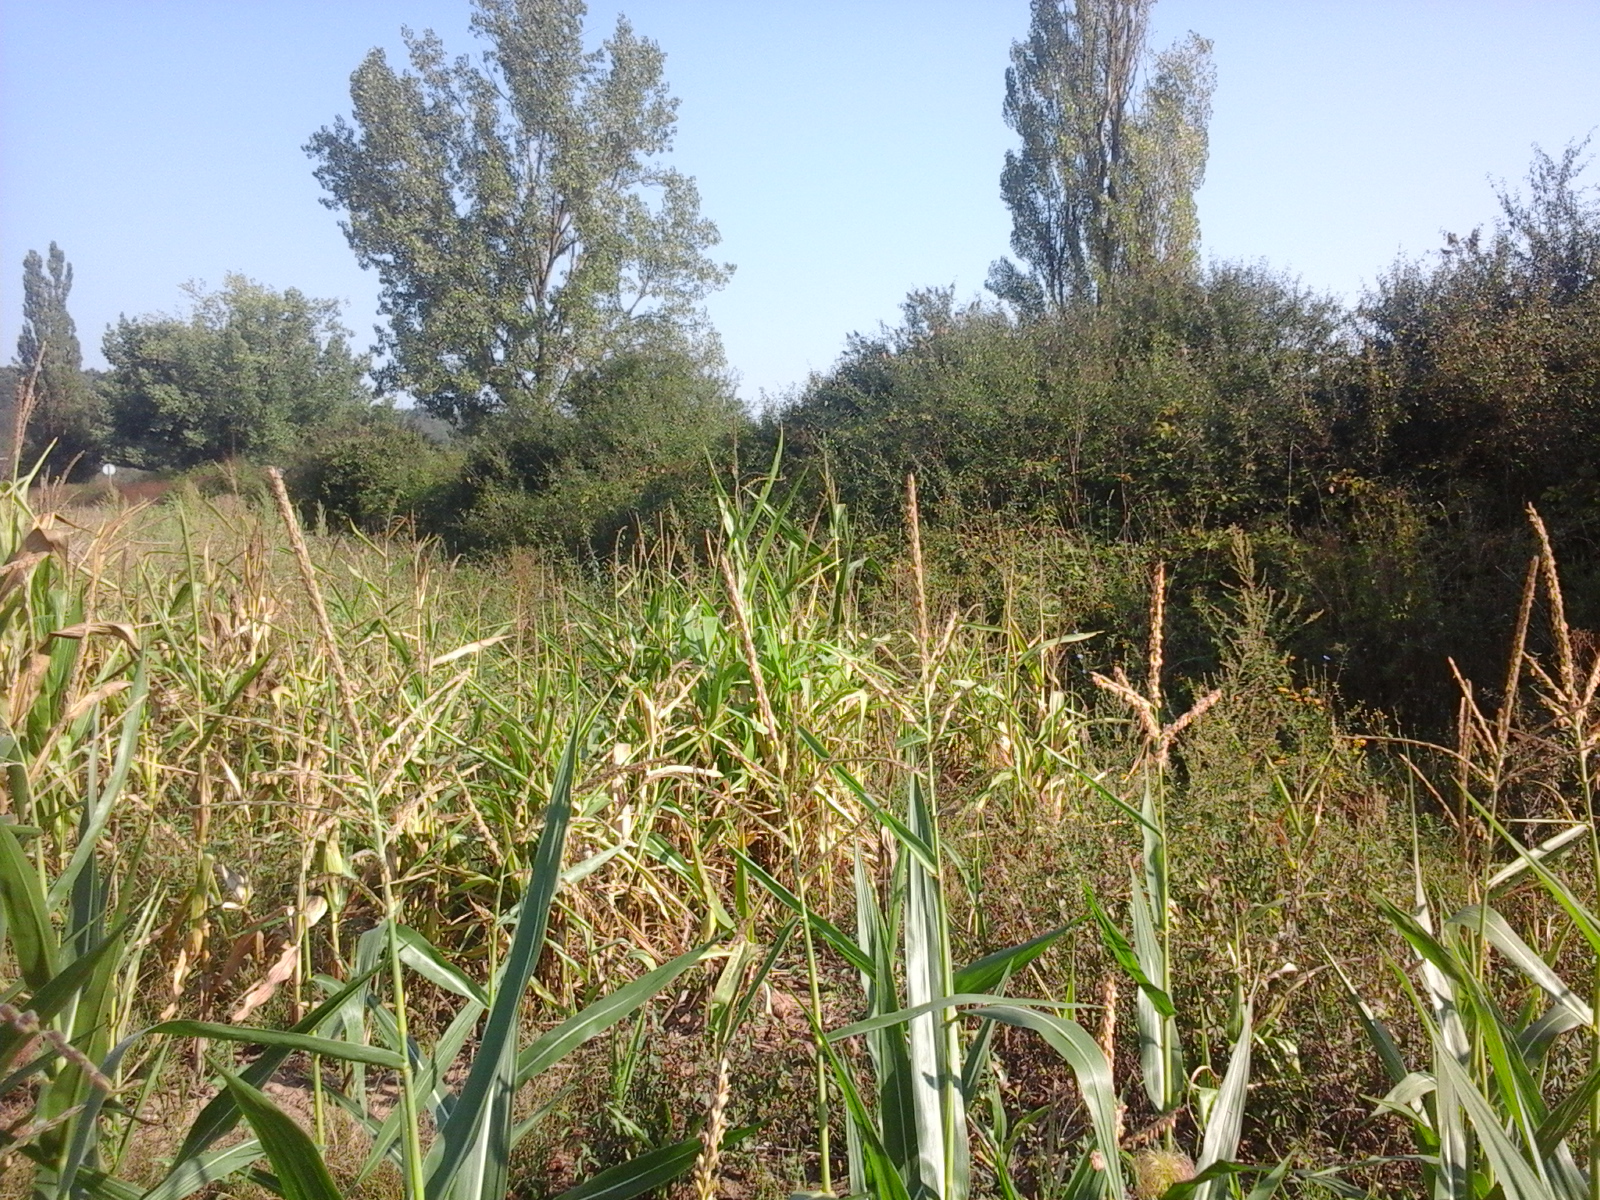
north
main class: Cropland
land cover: Maize
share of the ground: > 75 %
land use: Agriculture (excluding fallow land and kitchen gardens)
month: August
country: RO
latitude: 46.0202
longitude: 22.1470
